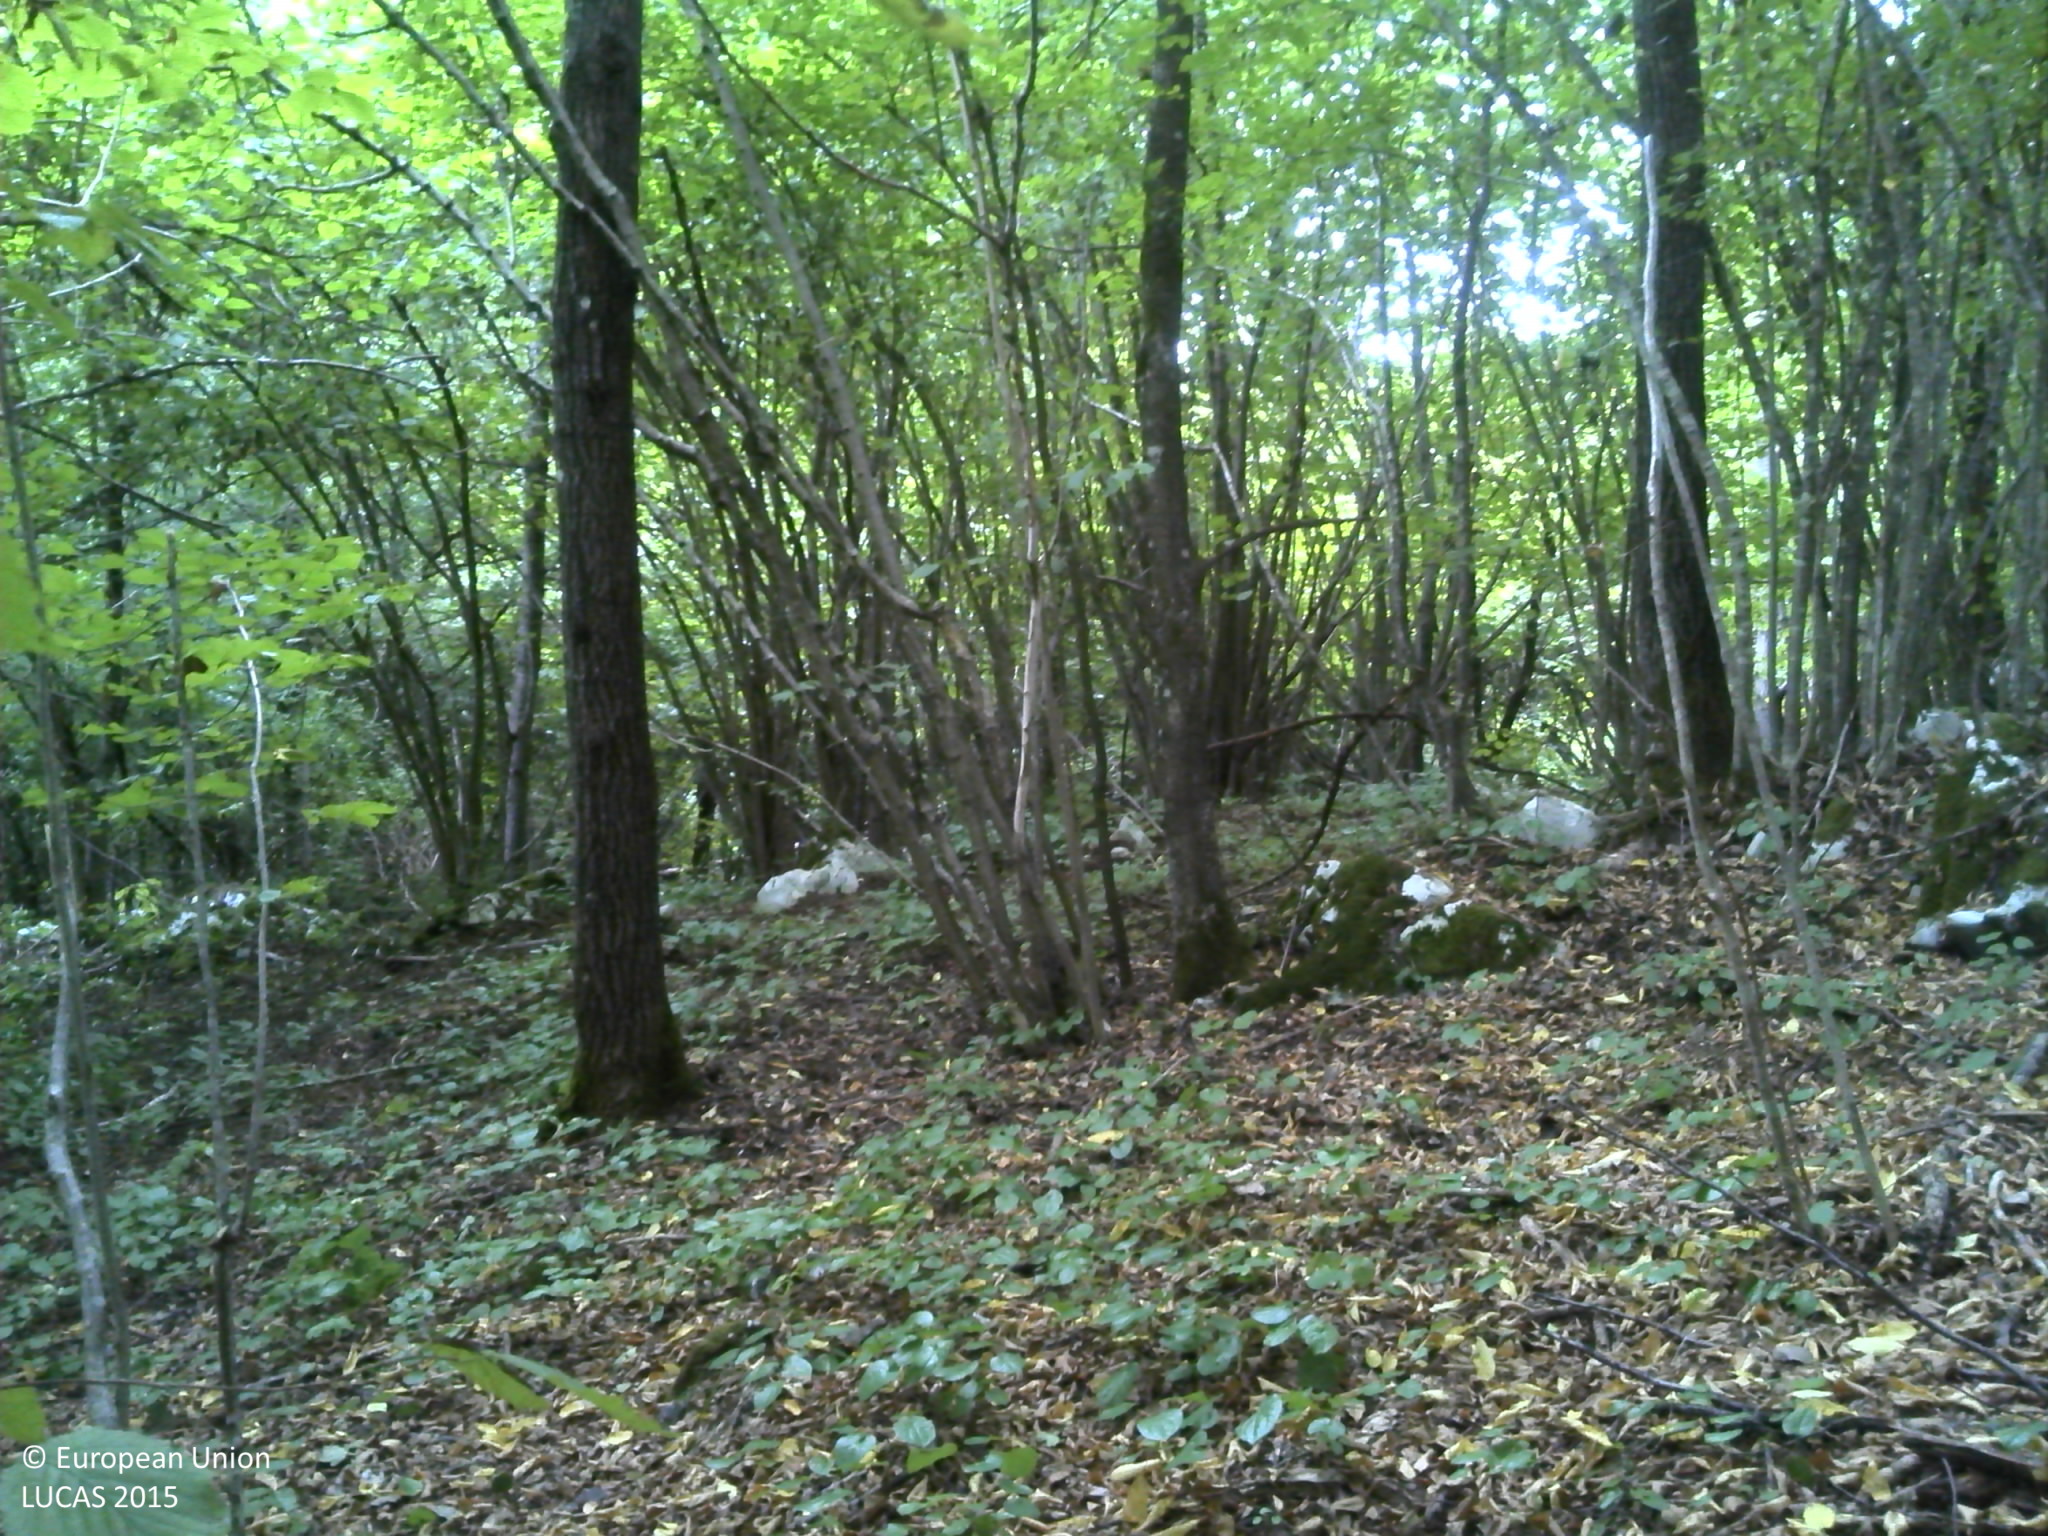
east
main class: Woodland
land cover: Broadleaved woodland
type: acidophilous oak and oak-birch forest
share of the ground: > 75 %
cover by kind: broadleaved forest trees 100 %
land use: Forestry
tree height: > 5 m
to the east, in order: Broadleaved woodland; Clovers; Broadleaved woodland; Temporary grasslands
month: September
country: HR
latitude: 45.4075
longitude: 15.2981
